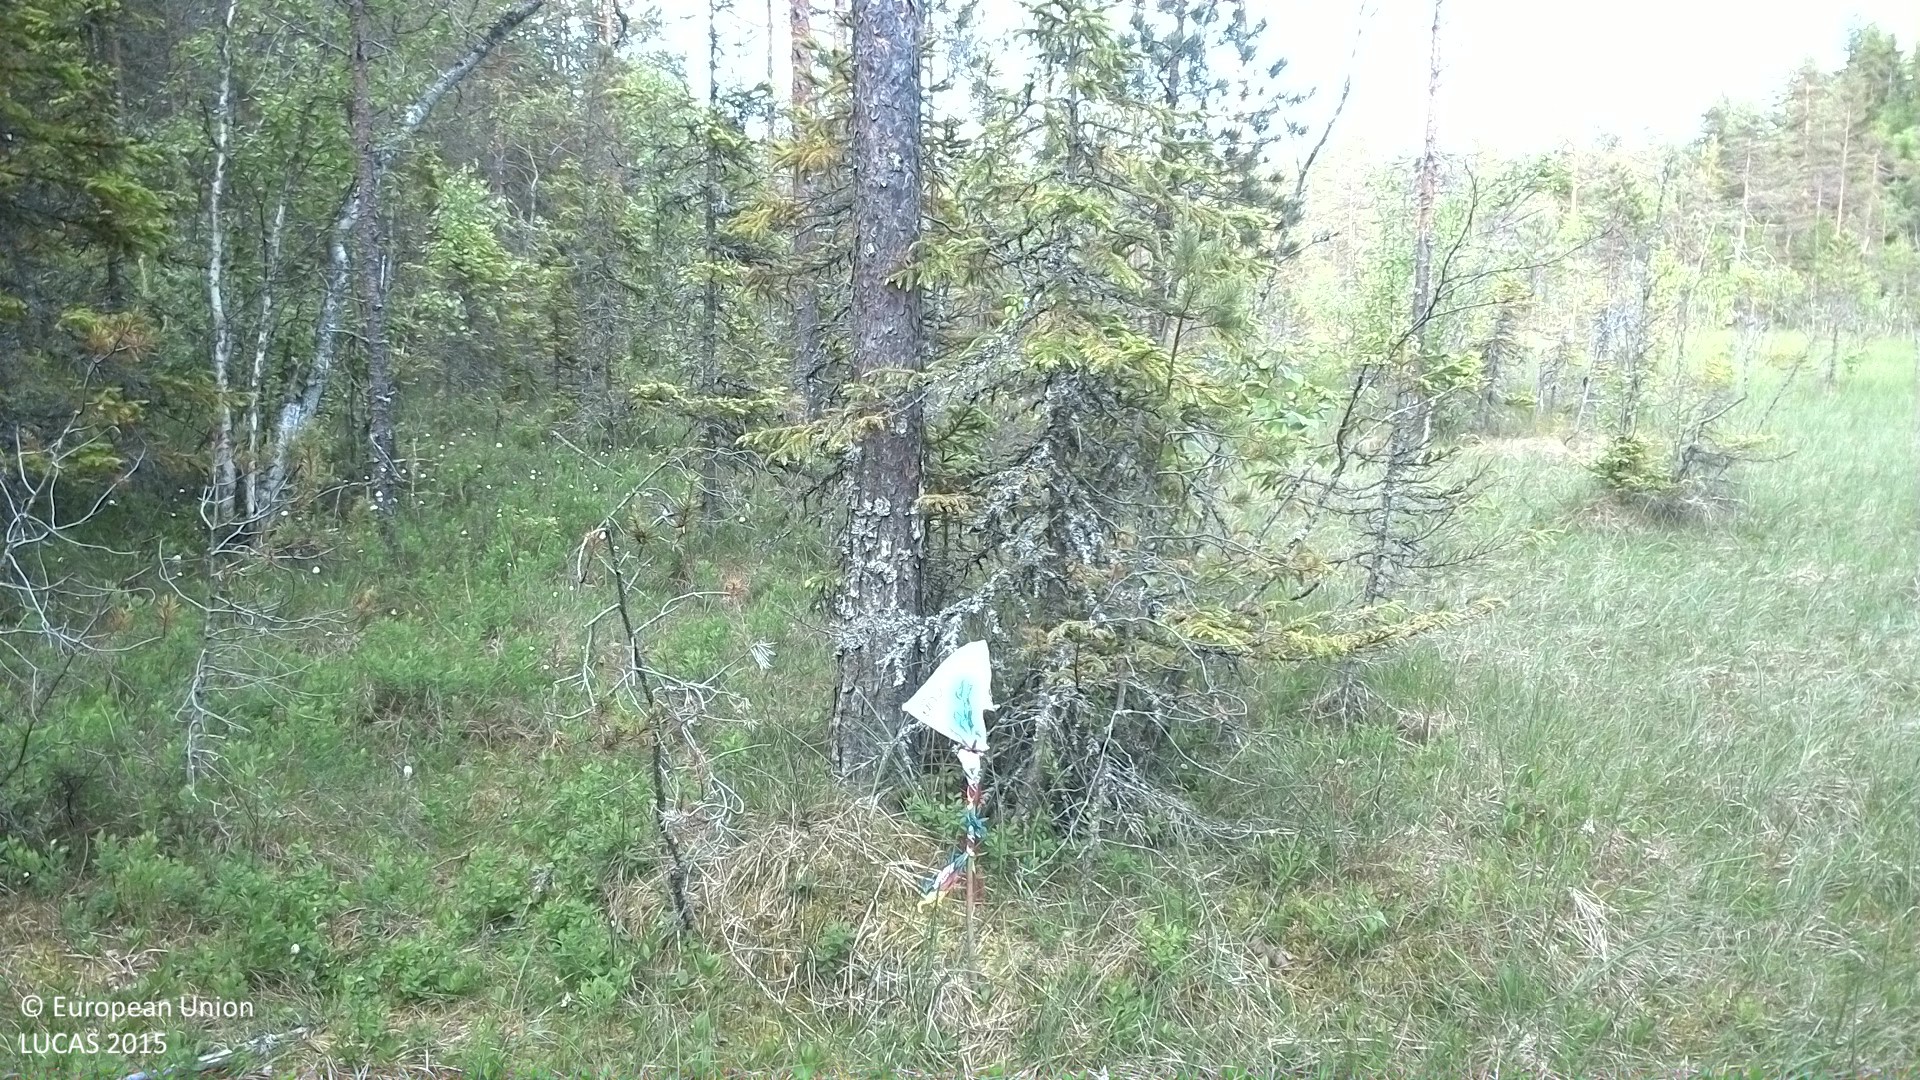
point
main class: Woodland
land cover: Pine dominated coniferous woodland
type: boreal forest
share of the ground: 50 - 75 %
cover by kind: lichens and mosses 55 %, coniferous forest trees 40 %, broadleaved forest trees 5 %
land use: Semi-natural and natural areas not in use
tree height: > 5 m
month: June
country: SE
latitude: 61.9507
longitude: 16.8258
